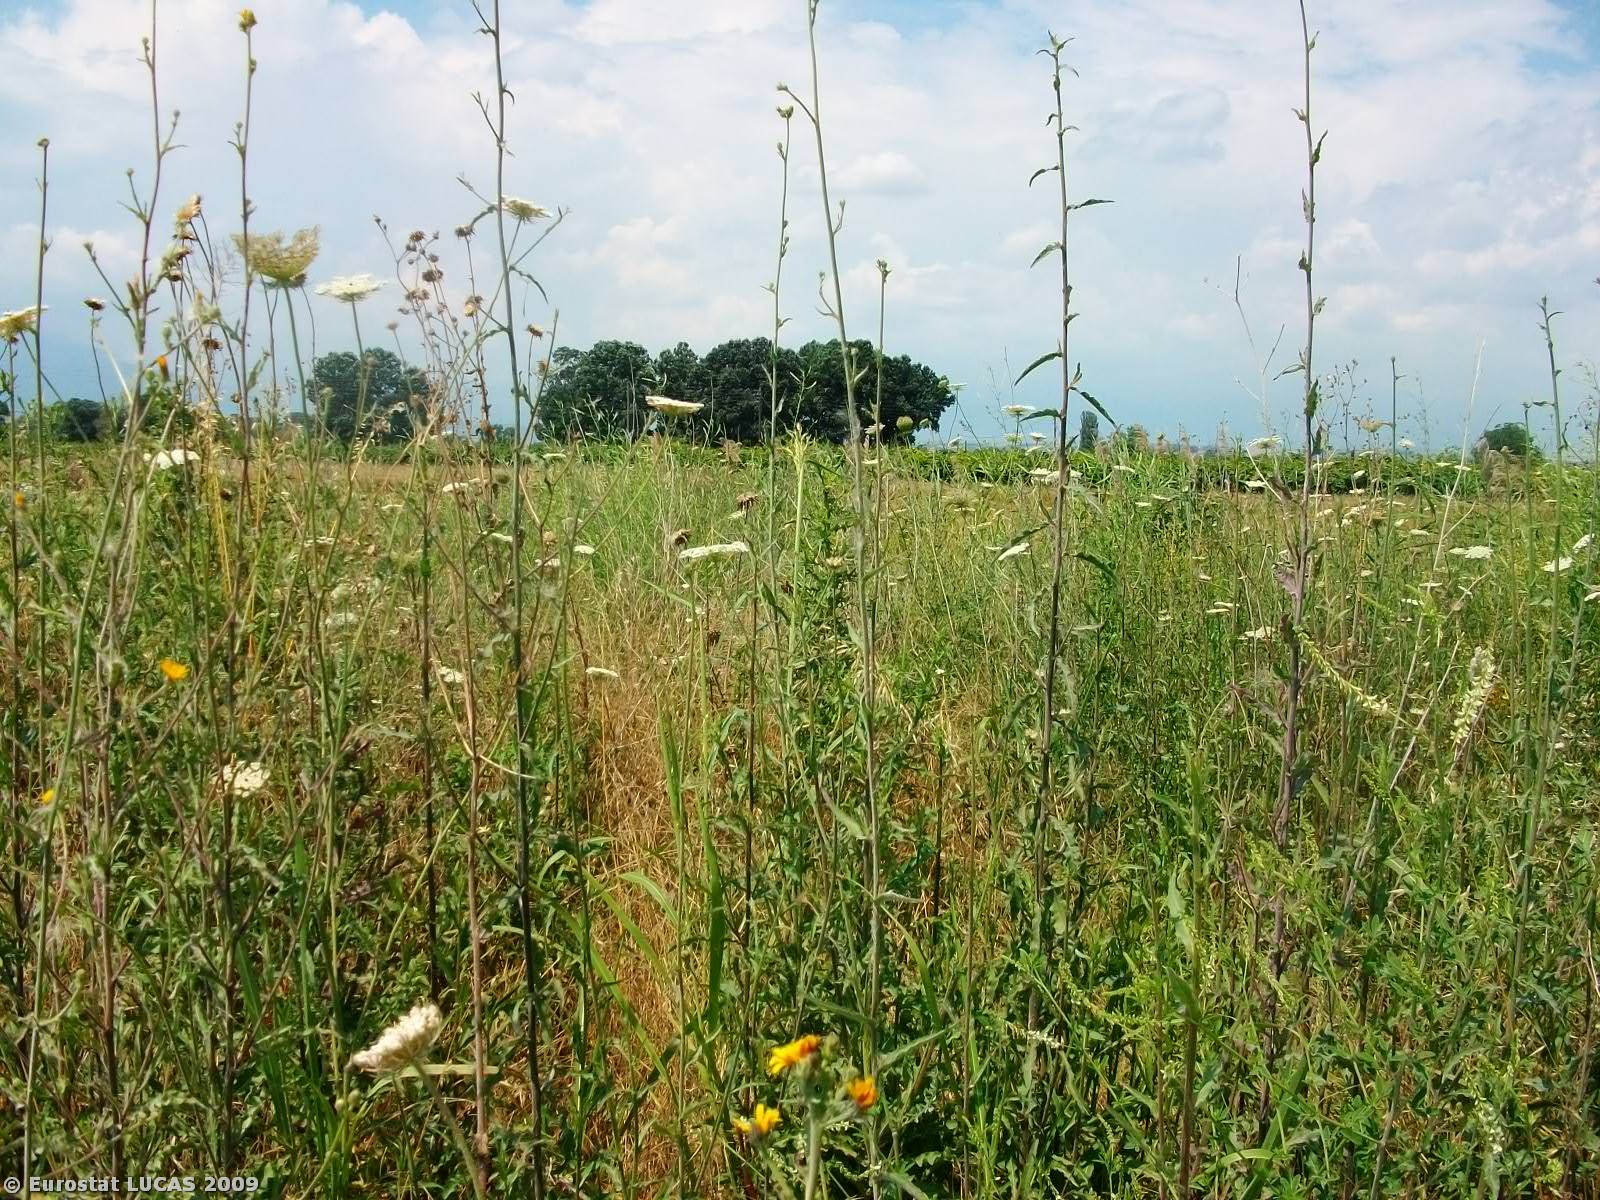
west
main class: Grassland
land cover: Spontaneously vegetated surfaces
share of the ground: > 75 %
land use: Fallow land
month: July
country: GR
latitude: 40.2276
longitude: 22.5378
